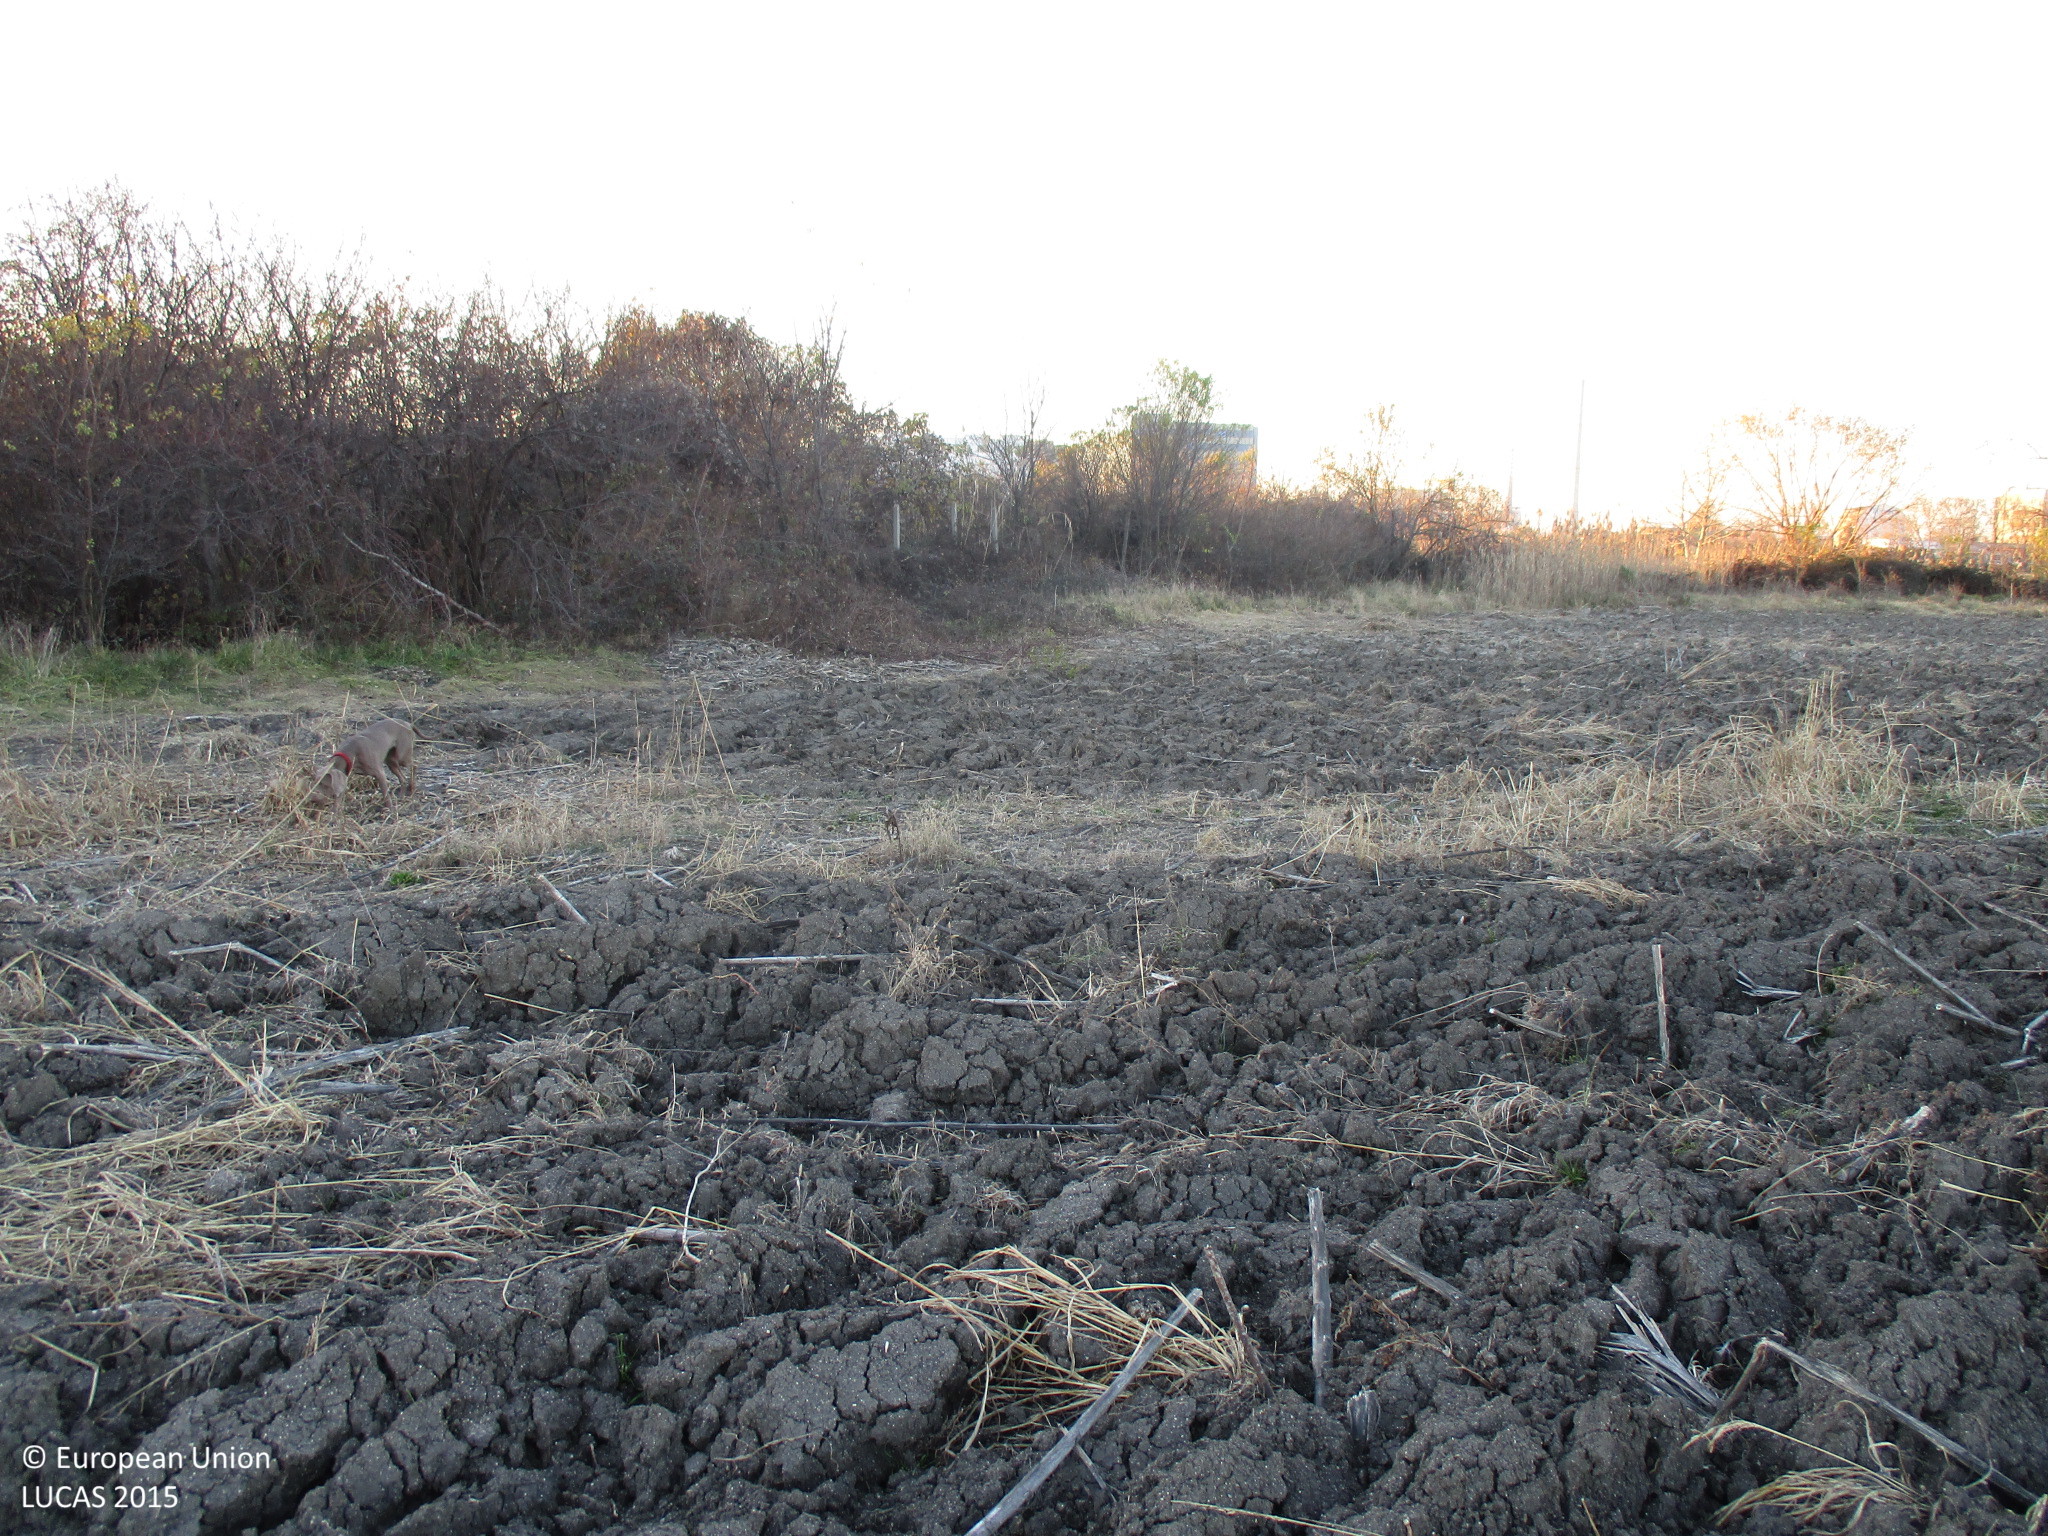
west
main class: Cropland
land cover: Sunflower
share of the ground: < 10 %
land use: Agriculture (excluding fallow land and kitchen gardens)
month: December
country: BG
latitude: 42.1707
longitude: 24.7598
